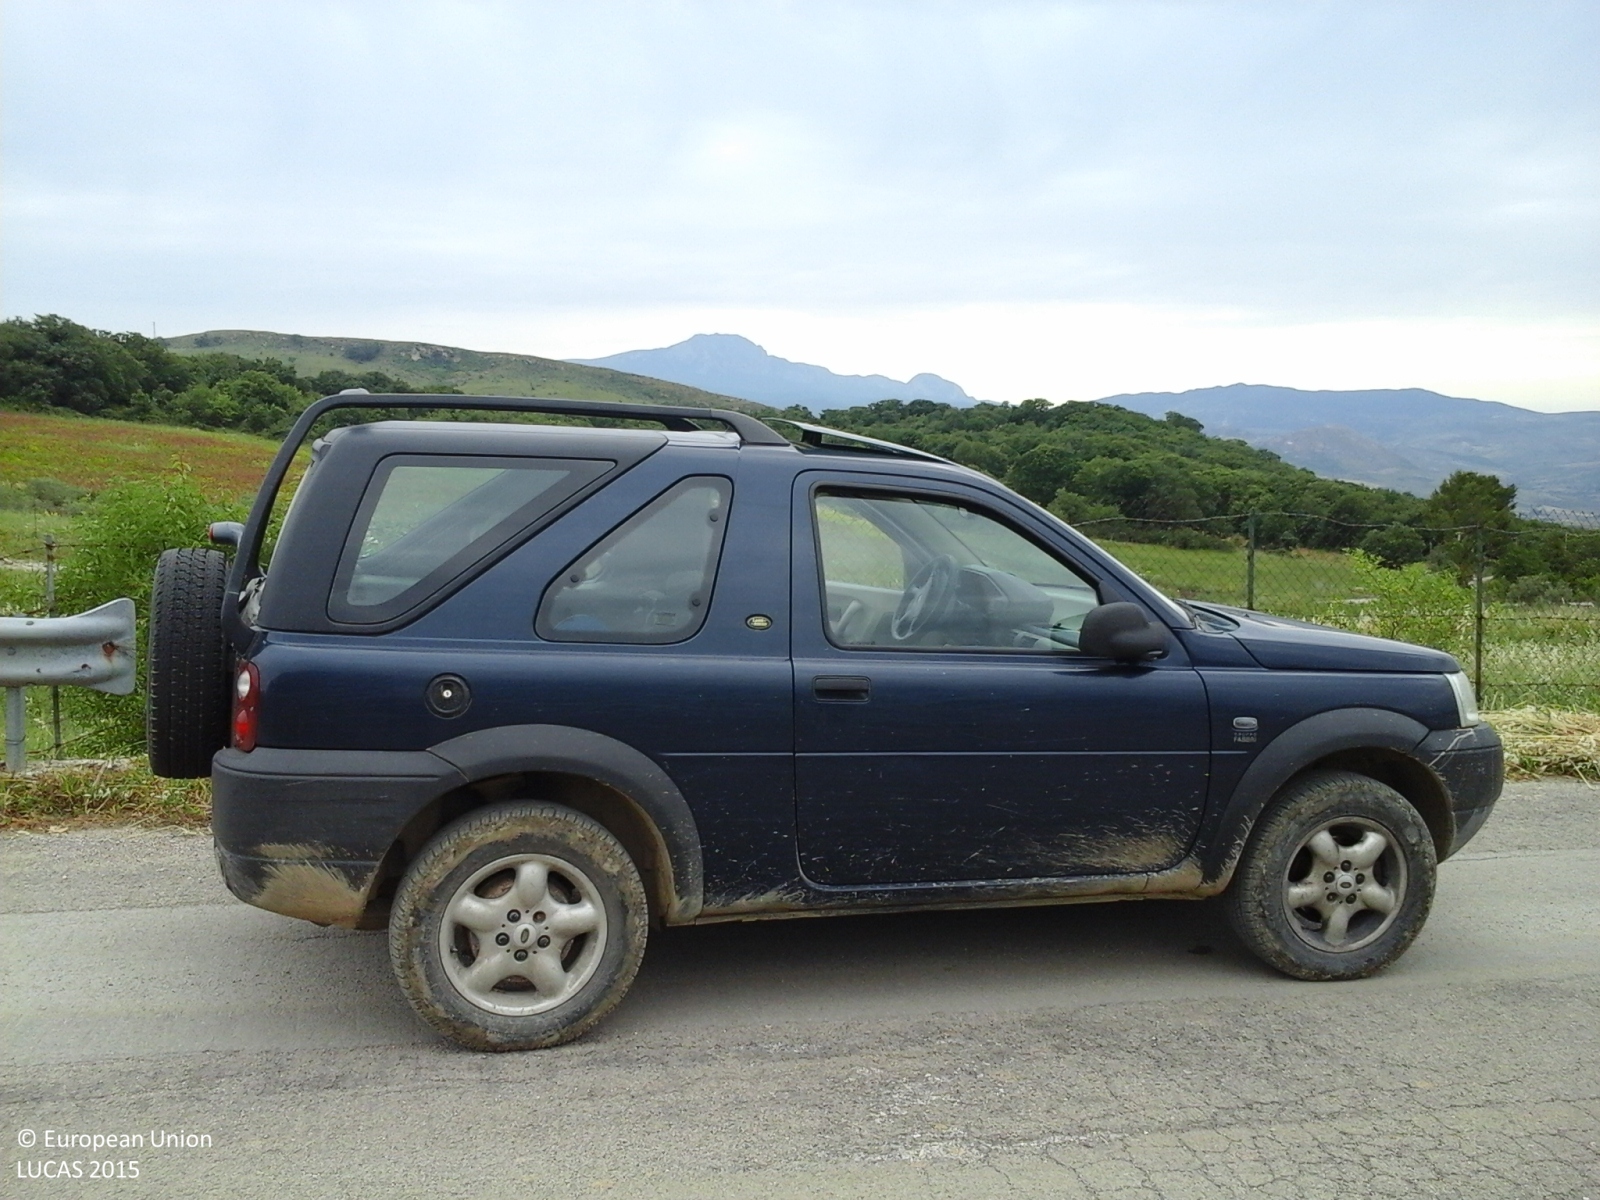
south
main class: Cropland
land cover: Other leguminous and mixtures for fodder
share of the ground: > 75 %
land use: Agriculture (excluding fallow land and kitchen gardens)
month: May
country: IT
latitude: 37.9353
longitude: 13.5587
